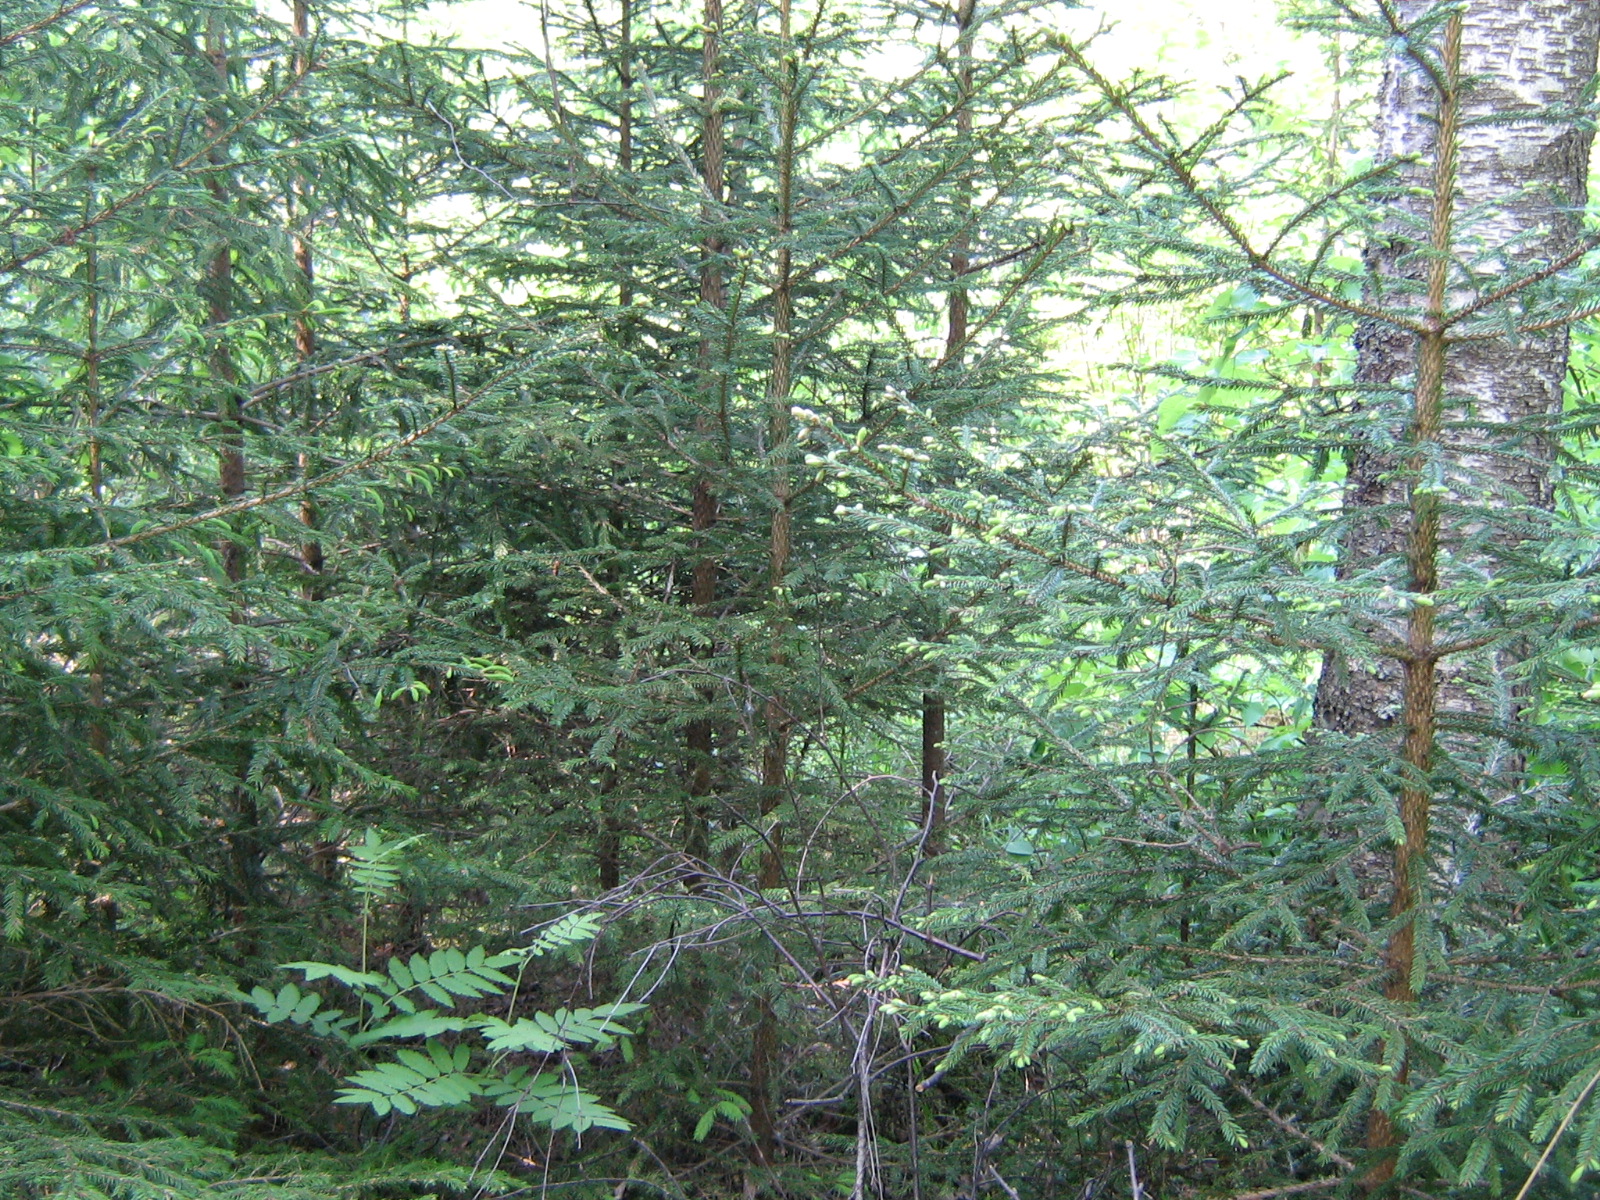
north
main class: Woodland
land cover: Spruce dominated mixed woodland
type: hemiboreal forest and nemoral coniferous forest and mixed broadleaved-coniferous forest
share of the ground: > 75 %
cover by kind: coniferous forest trees 65 %, broadleaved forest trees 35 %
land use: Forestry
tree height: > 5 m
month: June
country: LV
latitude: 56.8663
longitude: 25.3875
